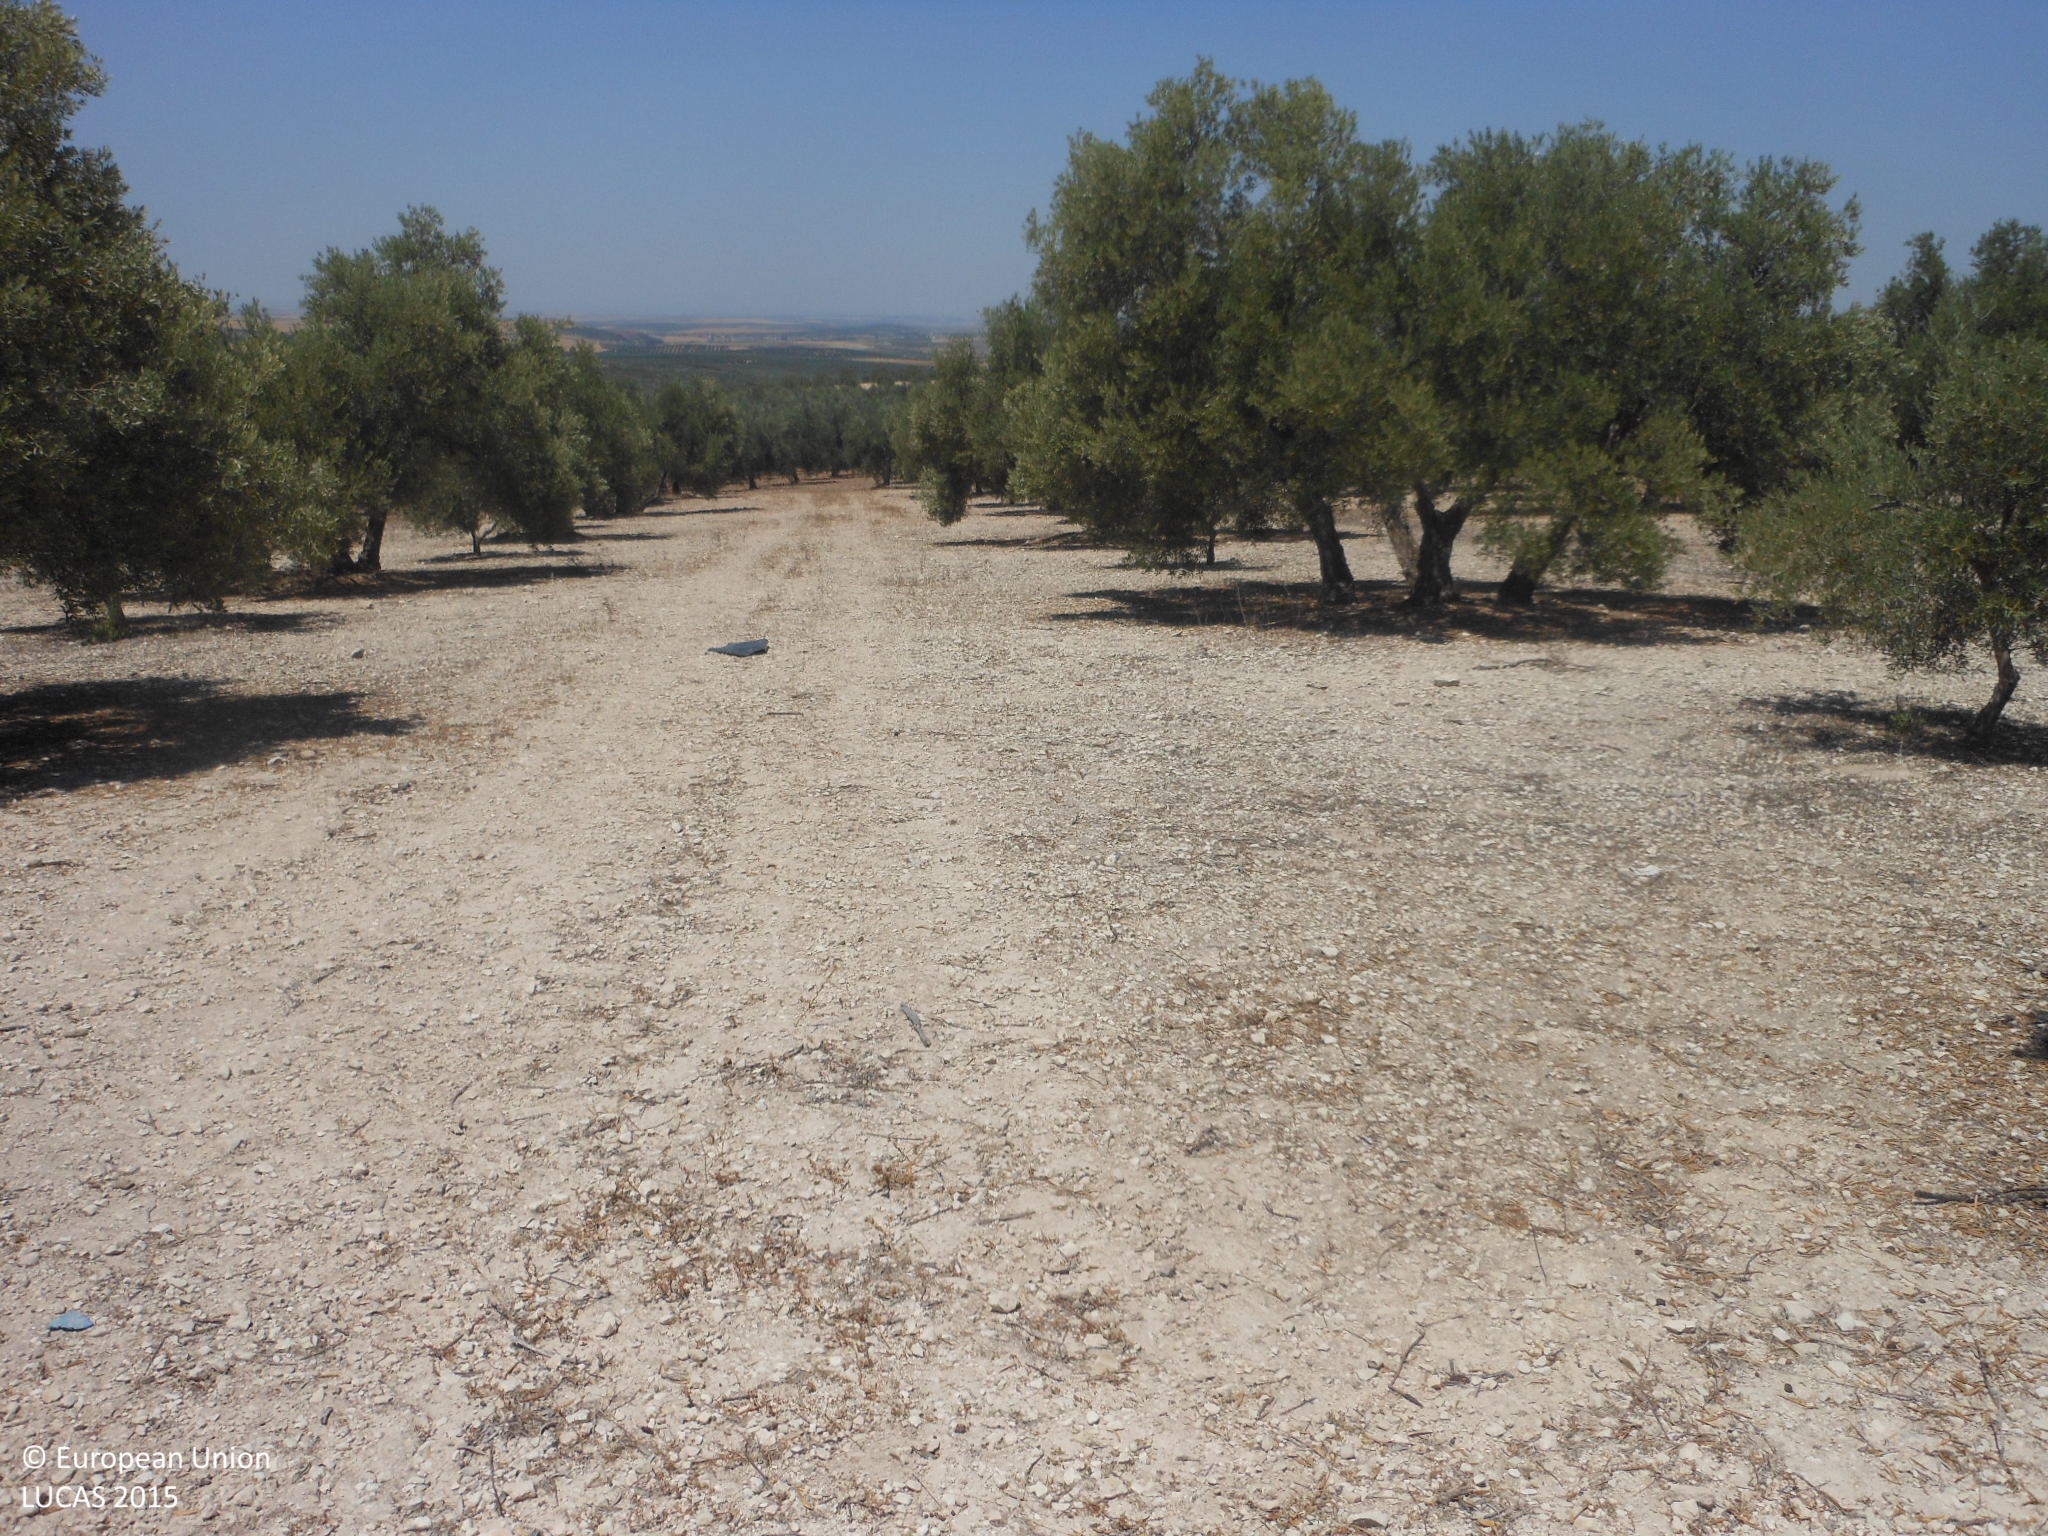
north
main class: Cropland
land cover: Olive groves
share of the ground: 50 - 75 %
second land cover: Other bare soil
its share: > 75 %
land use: Agriculture (excluding fallow land and kitchen gardens)
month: June
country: ES
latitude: 37.3616
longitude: -4.8766
